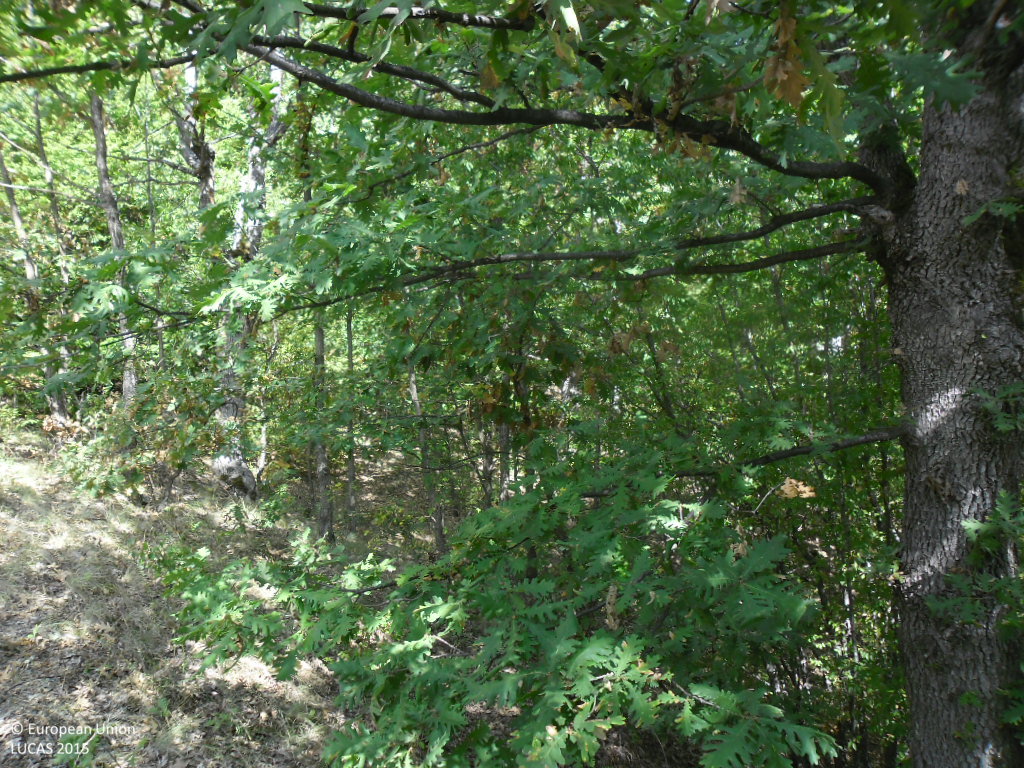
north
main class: Woodland
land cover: Broadleaved woodland
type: mesophytic deciduous forest
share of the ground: > 75 %
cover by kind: broadleaved forest trees 95 %, shrubs 5 %
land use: Forestry
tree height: > 5 m
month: September
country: BG
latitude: 41.8528
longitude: 22.9693
